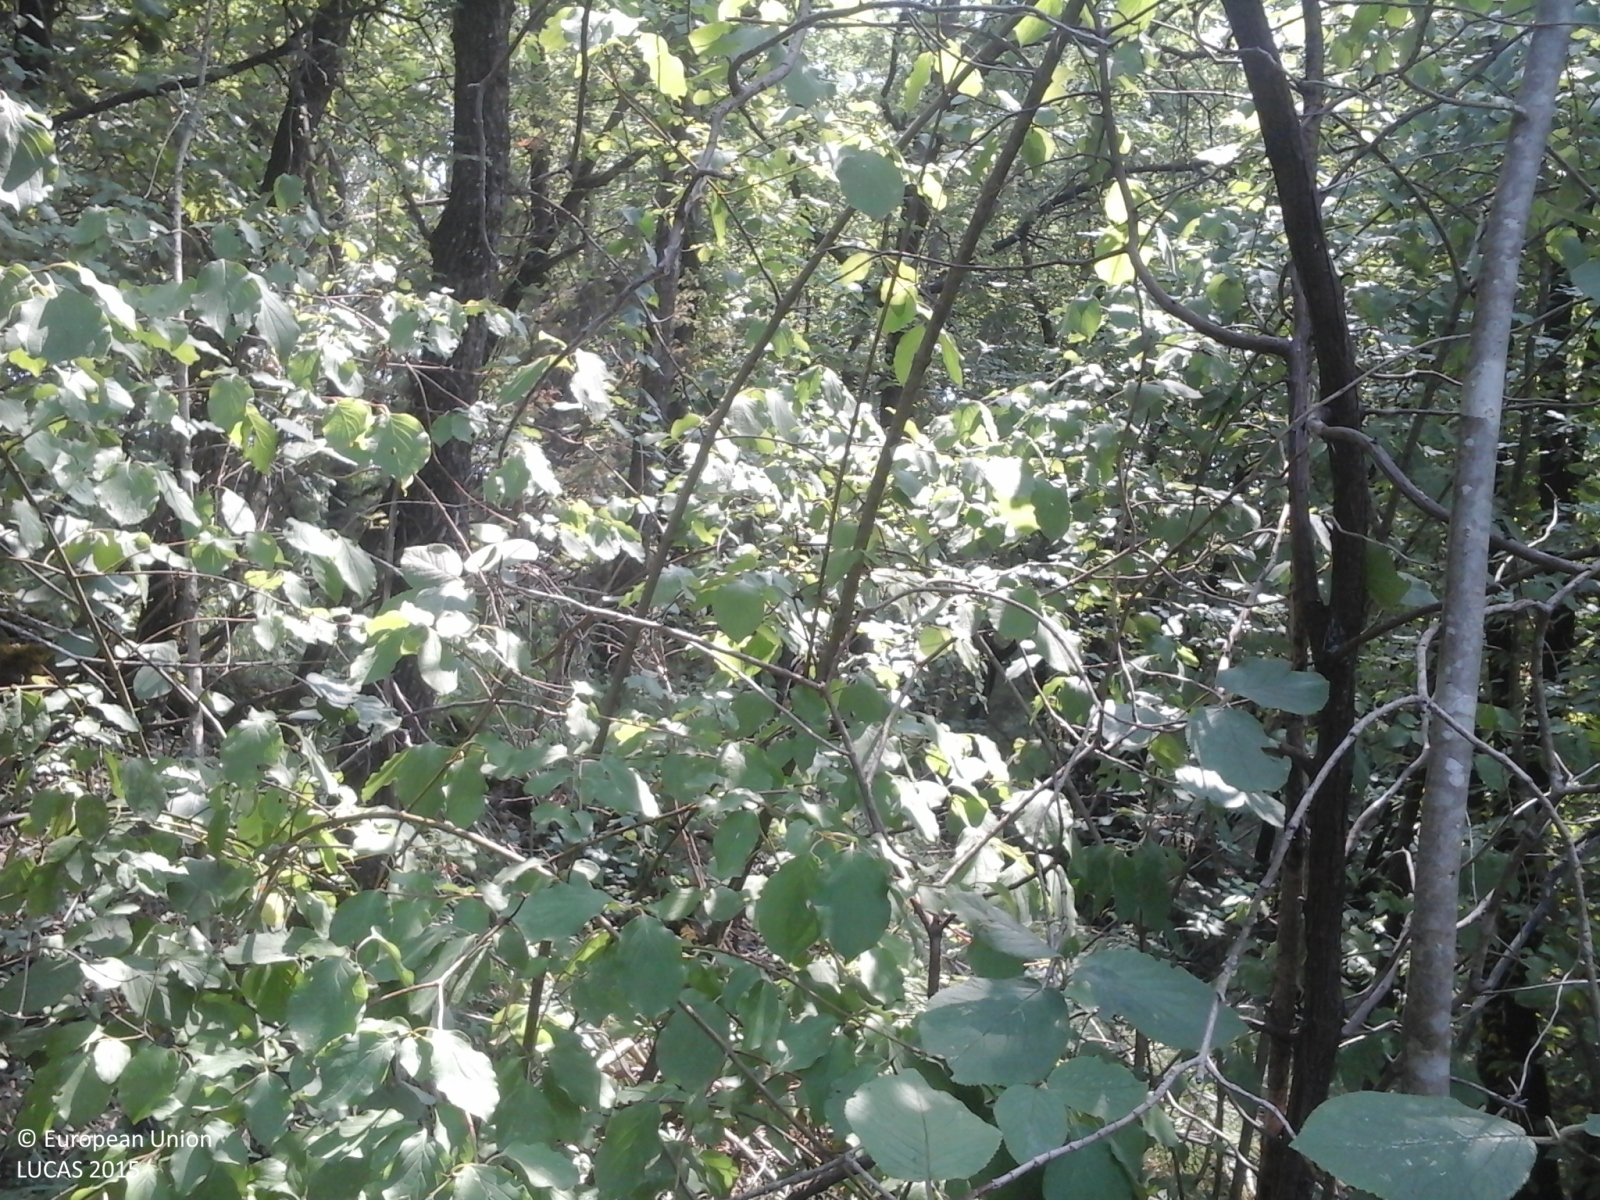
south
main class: Woodland
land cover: Broadleaved woodland
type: thermophilous deciduous forest
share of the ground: > 75 %
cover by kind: broadleaved forest trees 90 %, coniferous forest trees 10 %
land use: Forestry
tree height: > 5 m
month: July
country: IT
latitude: 44.4582
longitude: 10.3386
